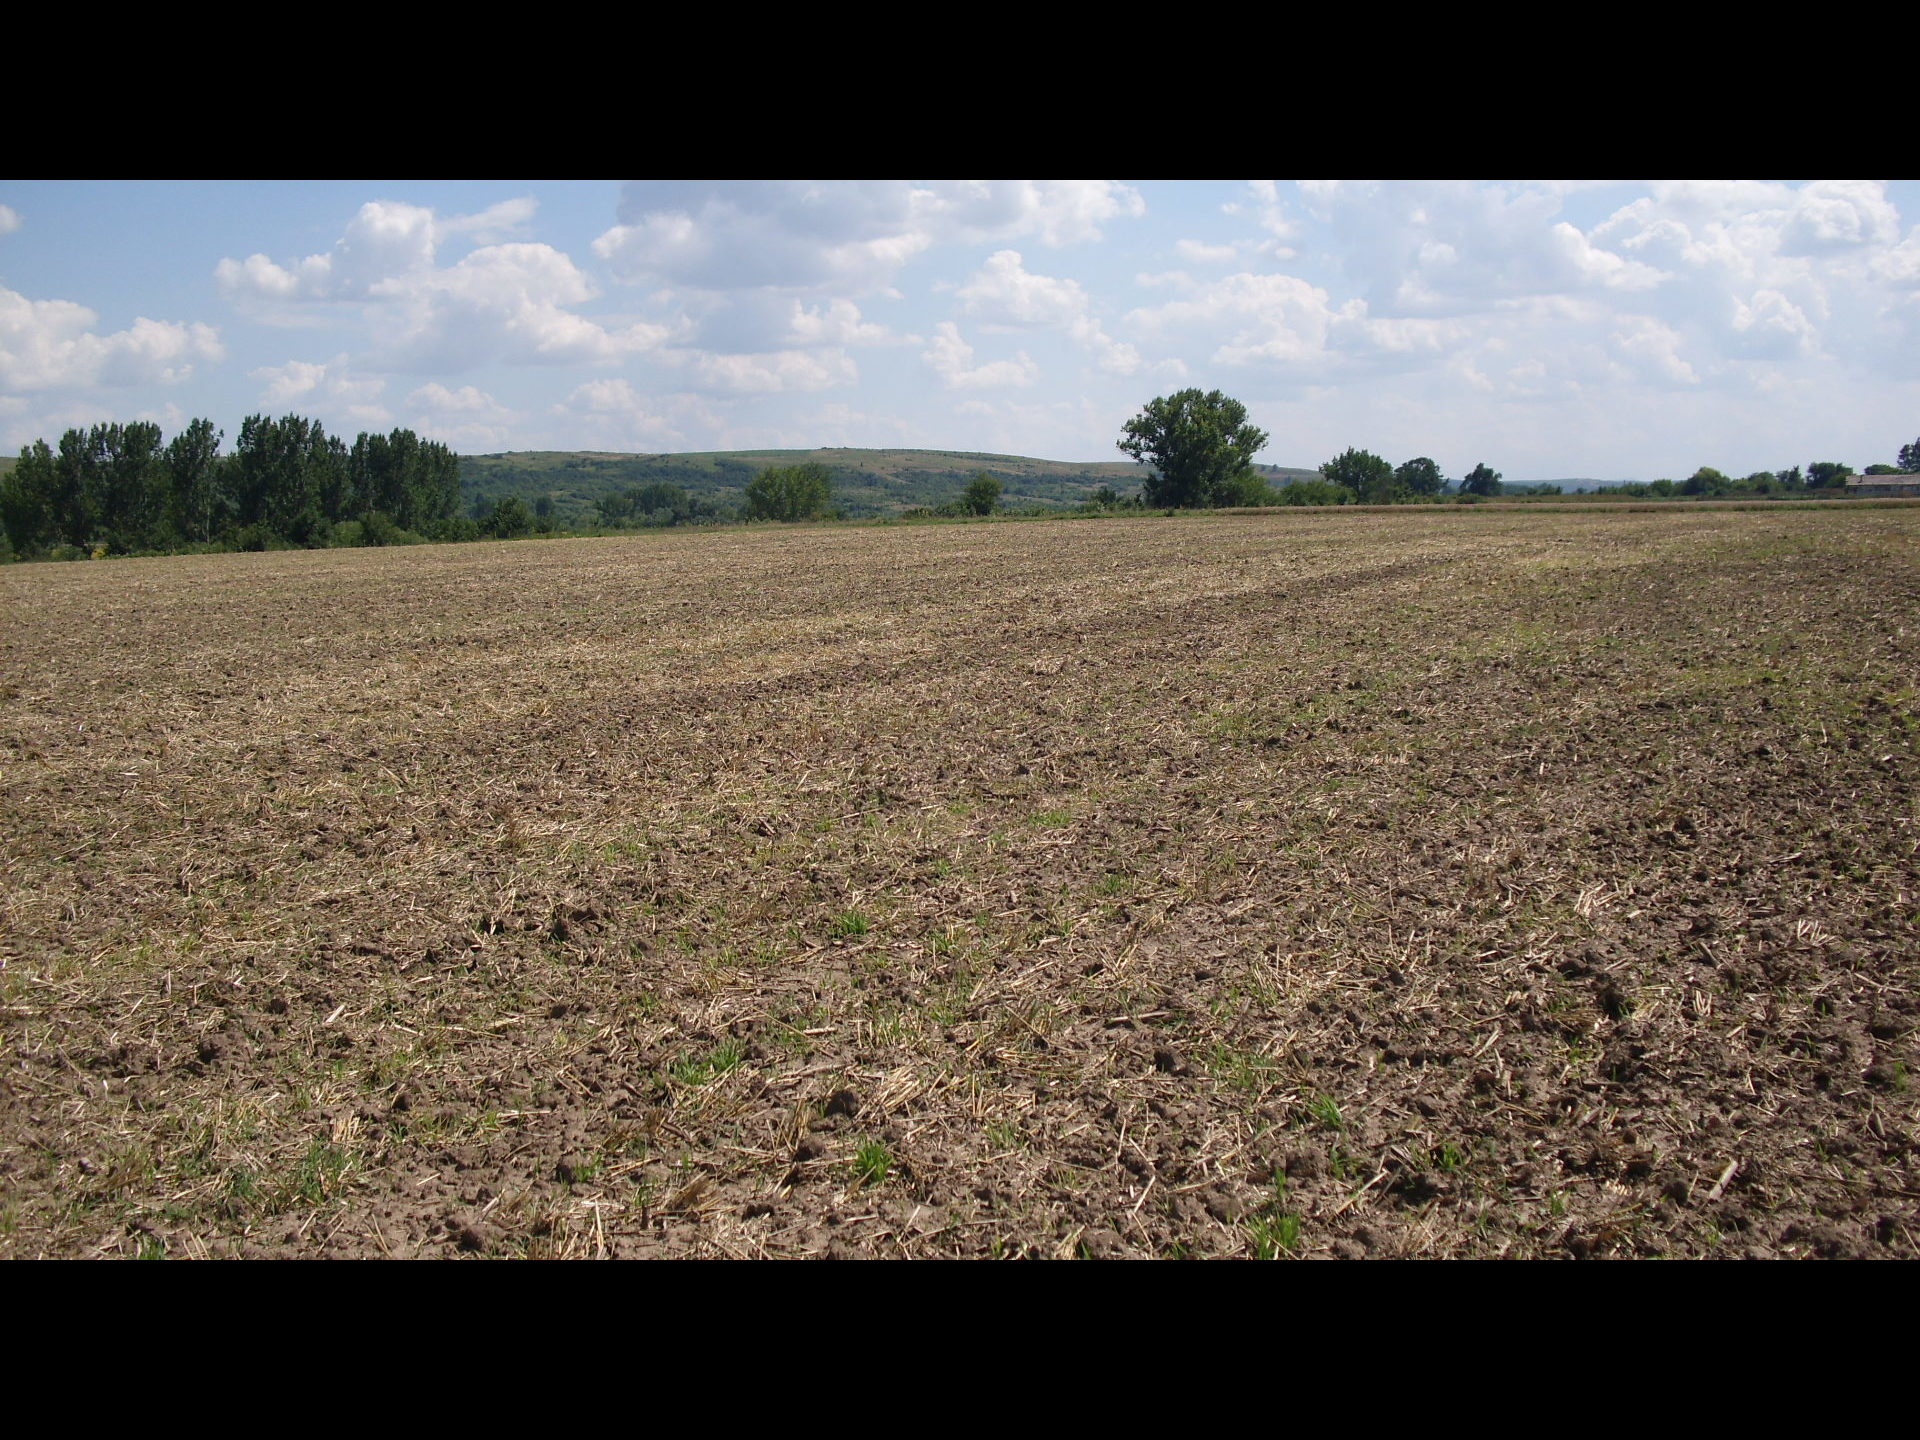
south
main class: Cropland
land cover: Barley
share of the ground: > 75 %
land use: Agriculture (excluding fallow land and kitchen gardens)
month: July
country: BG
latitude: 43.7241
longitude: 23.4651
